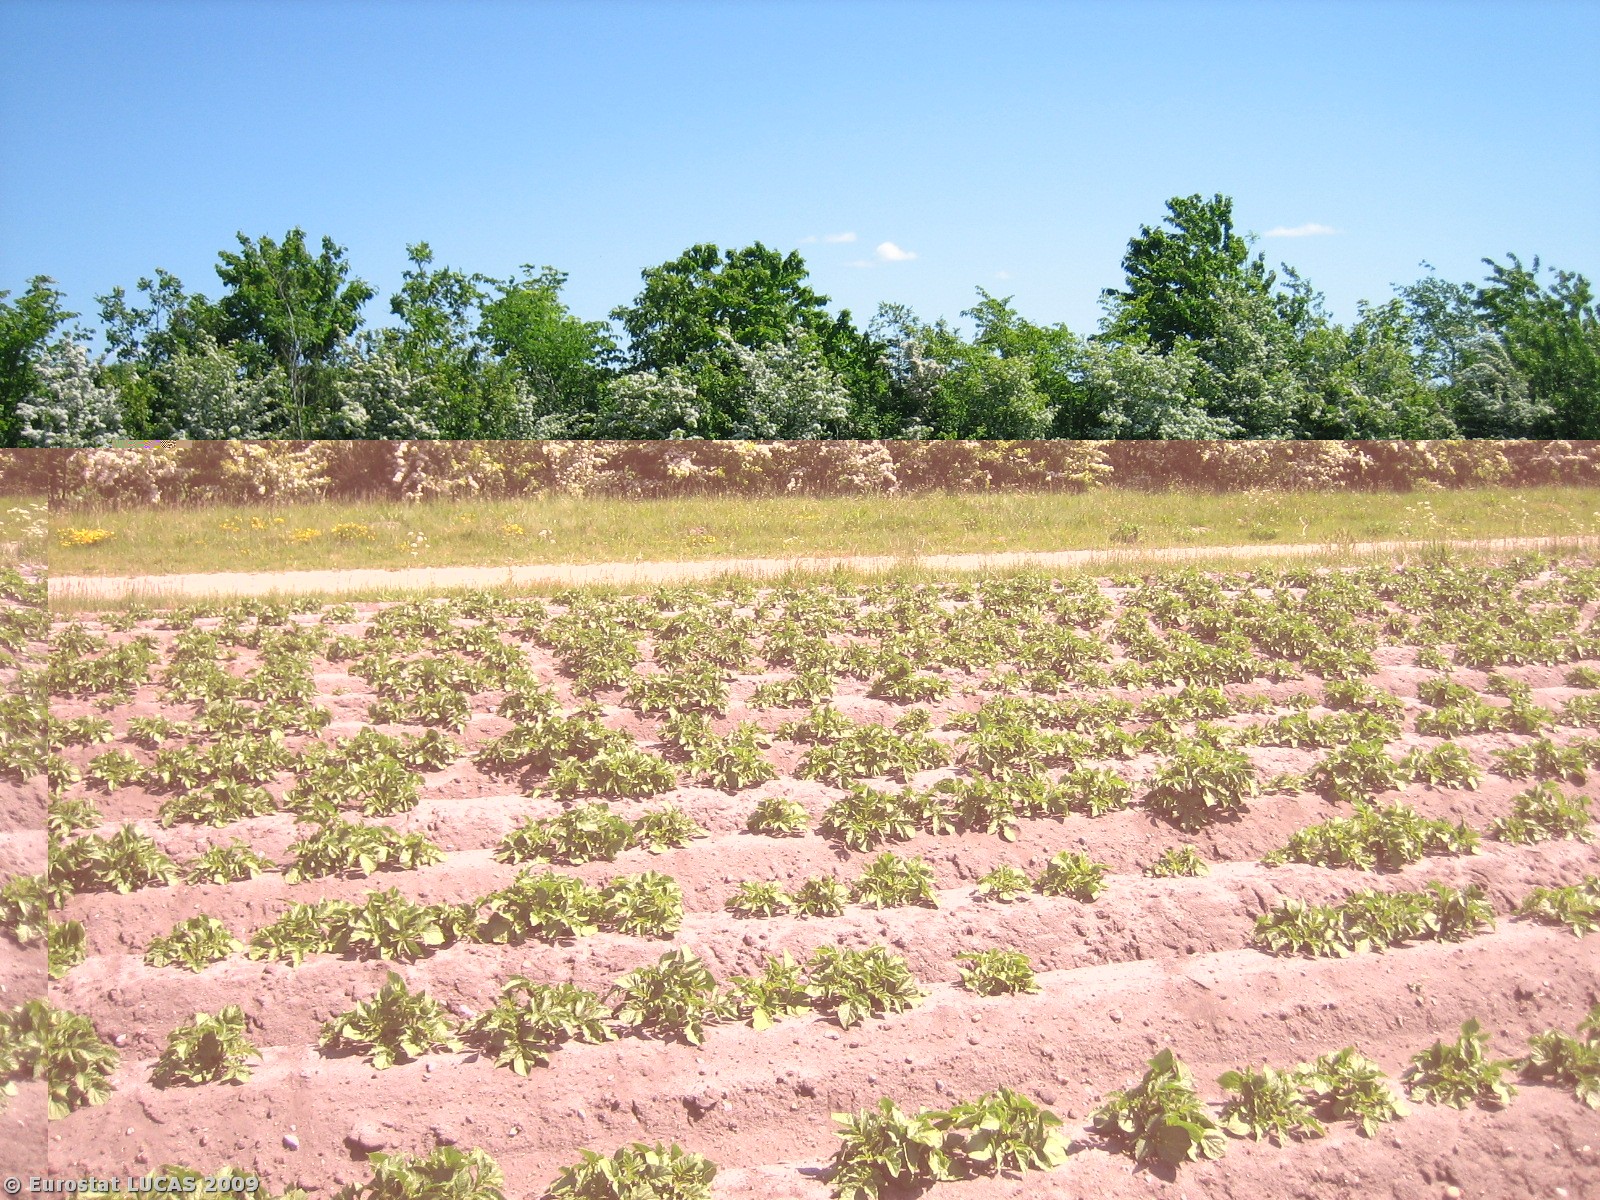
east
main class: Cropland
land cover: Potatoes
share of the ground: 10 - 25 %
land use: Agriculture (excluding fallow land and kitchen gardens)
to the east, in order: Potatoes; Grass margins; Tracks; Grass margins; Shrubland with sparse tree cover; Barley; Broadleaved woodland; Potatoes
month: May
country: DK
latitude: 55.9128
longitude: 8.8333
